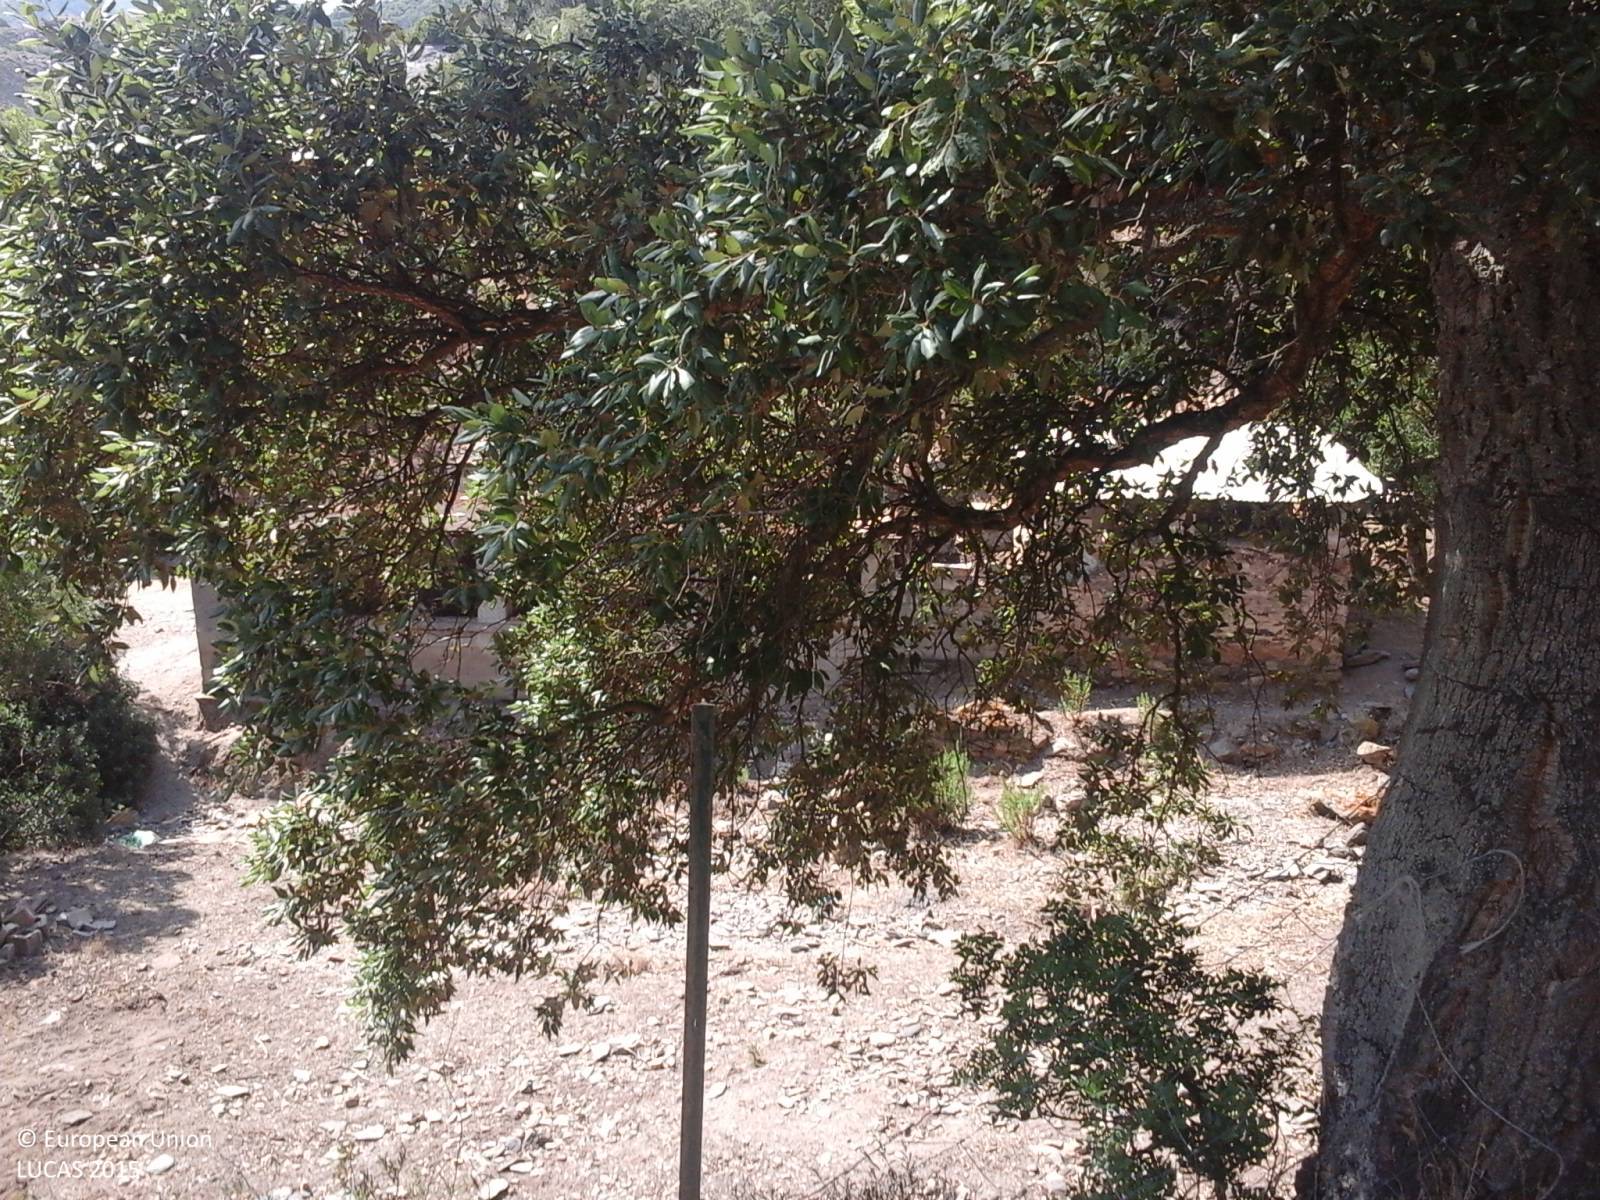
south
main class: Shrubland
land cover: Shrubland with sparse tree cover
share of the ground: > 75 %
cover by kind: shrubs 90 %, broadleaved forest trees 5 %, herbaceous plants 5 %
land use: Agriculture (excluding fallow land and kitchen gardens)
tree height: < 5 m
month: July
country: IT
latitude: 39.4402
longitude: 8.4638
